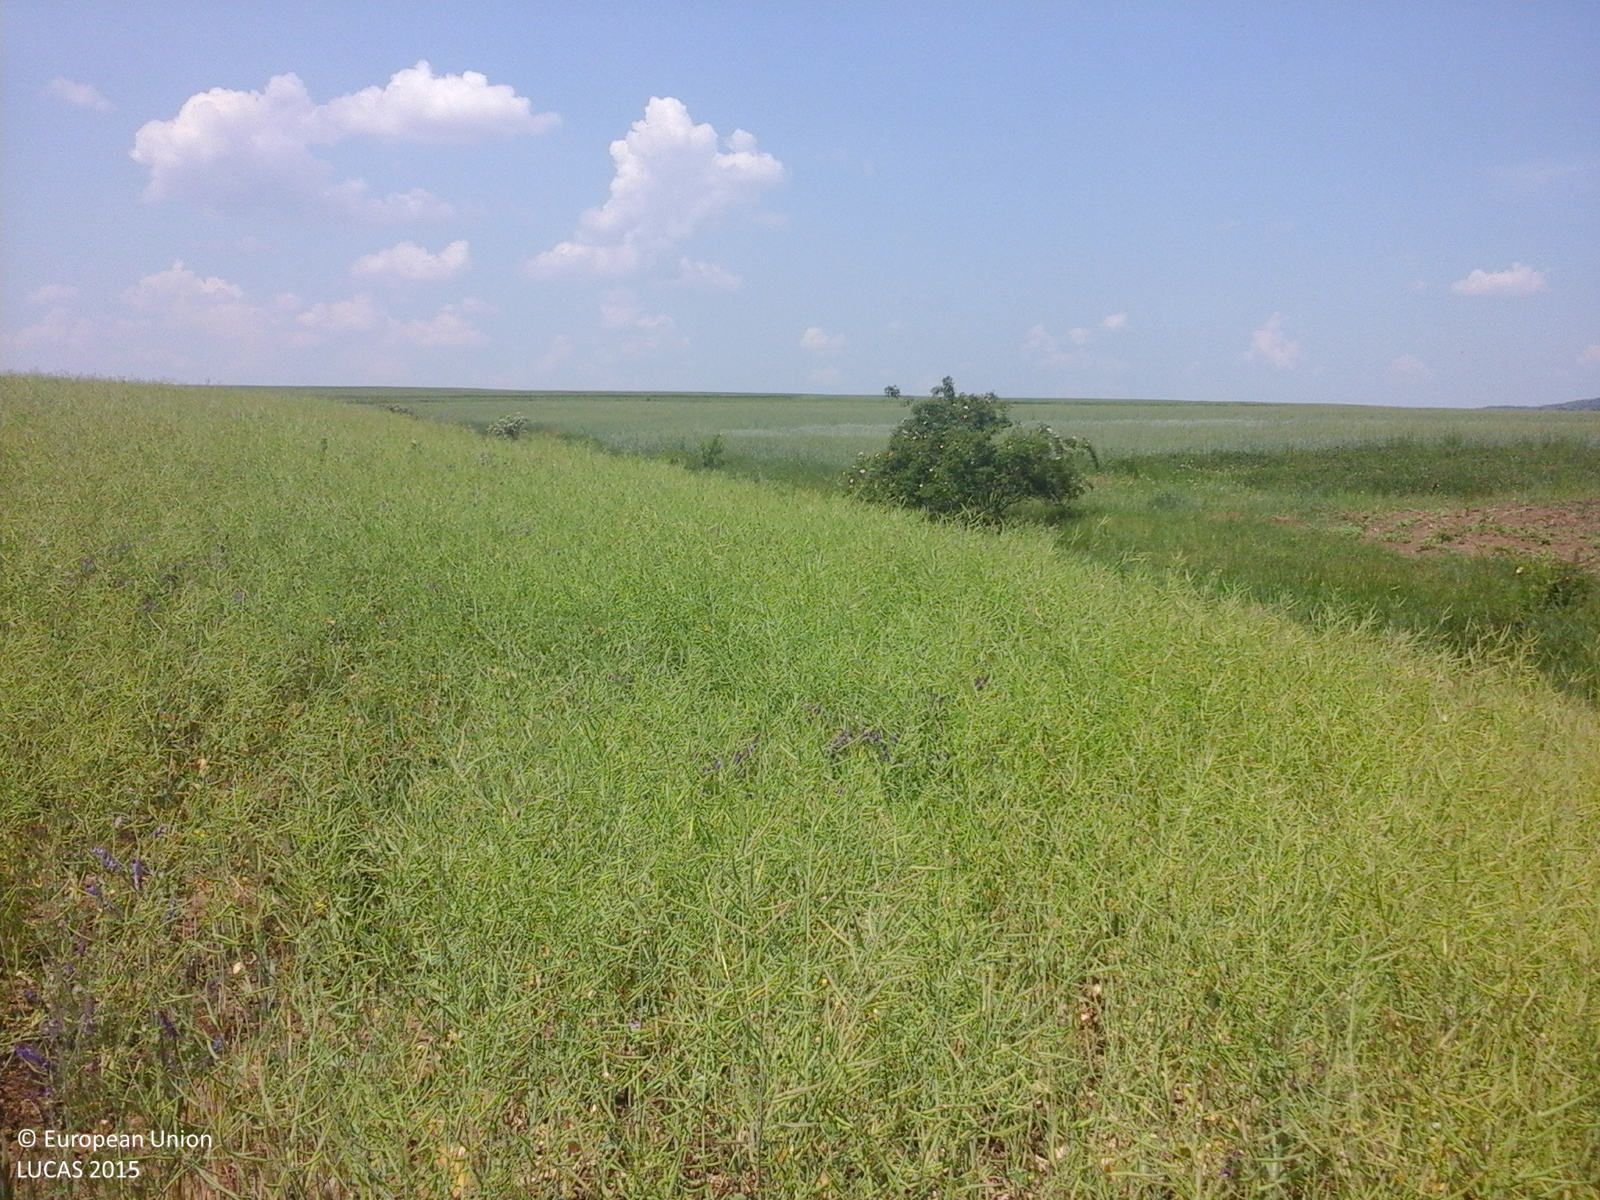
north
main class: Cropland
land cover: Rape and turnip rape
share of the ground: > 75 %
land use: Agriculture (excluding fallow land and kitchen gardens)
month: June
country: RO
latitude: 46.4663
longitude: 27.1191
